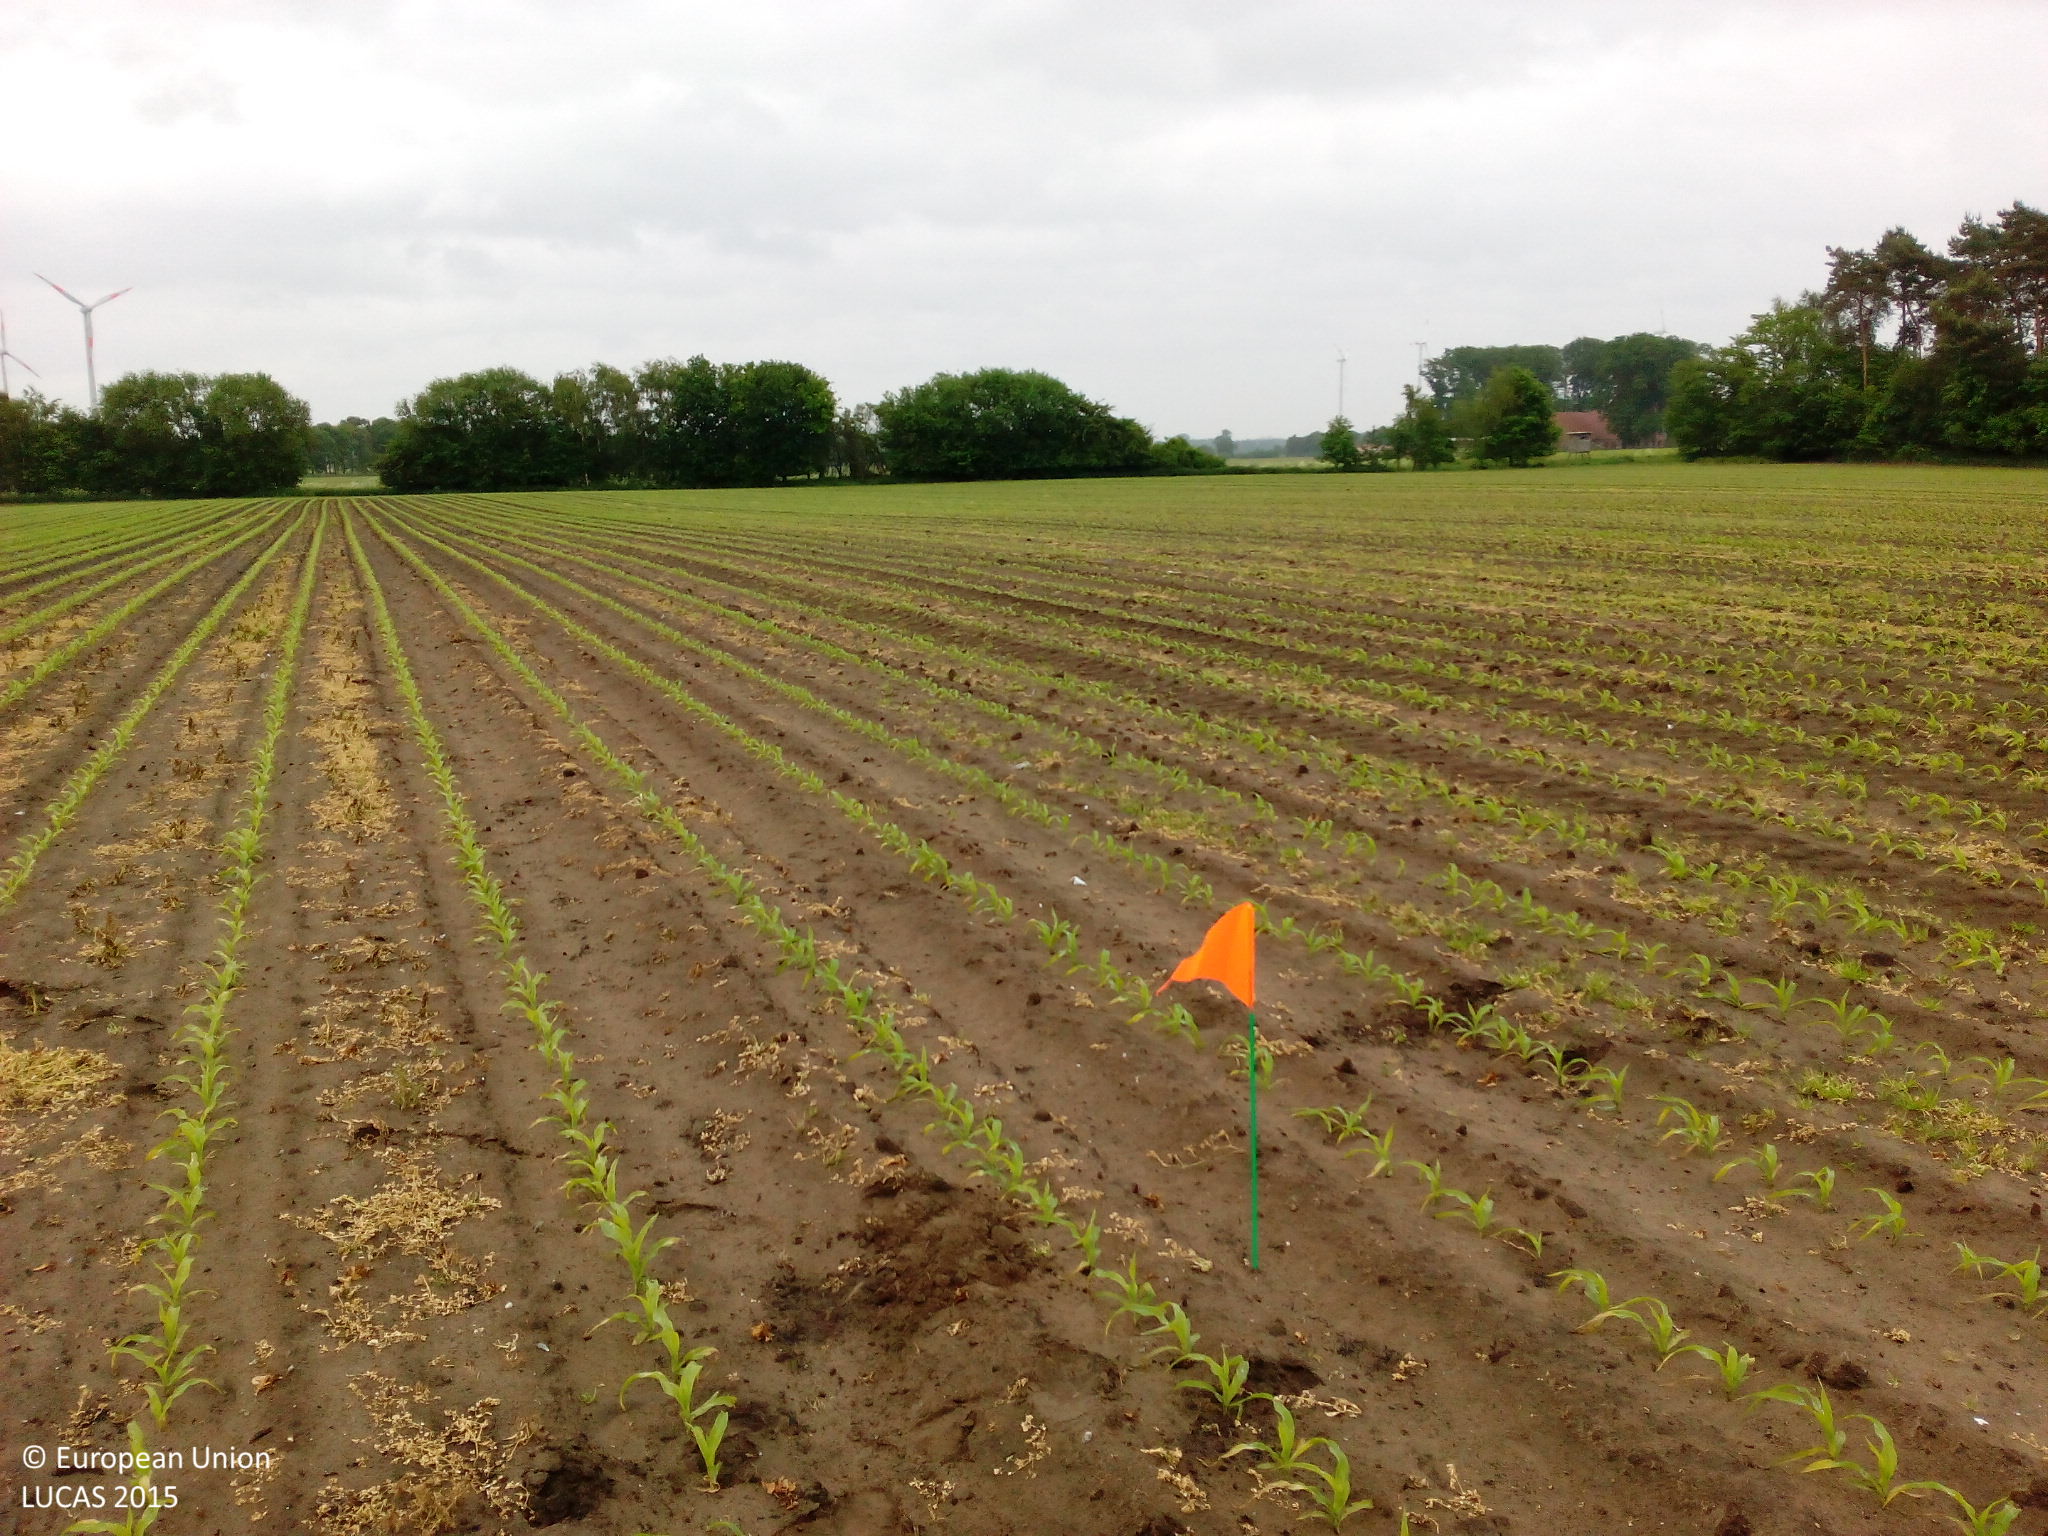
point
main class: Cropland
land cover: Maize
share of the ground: > 75 %
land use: Agriculture (excluding fallow land and kitchen gardens)
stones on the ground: < 10 %
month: June
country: DE
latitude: 52.3484
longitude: 7.3726
